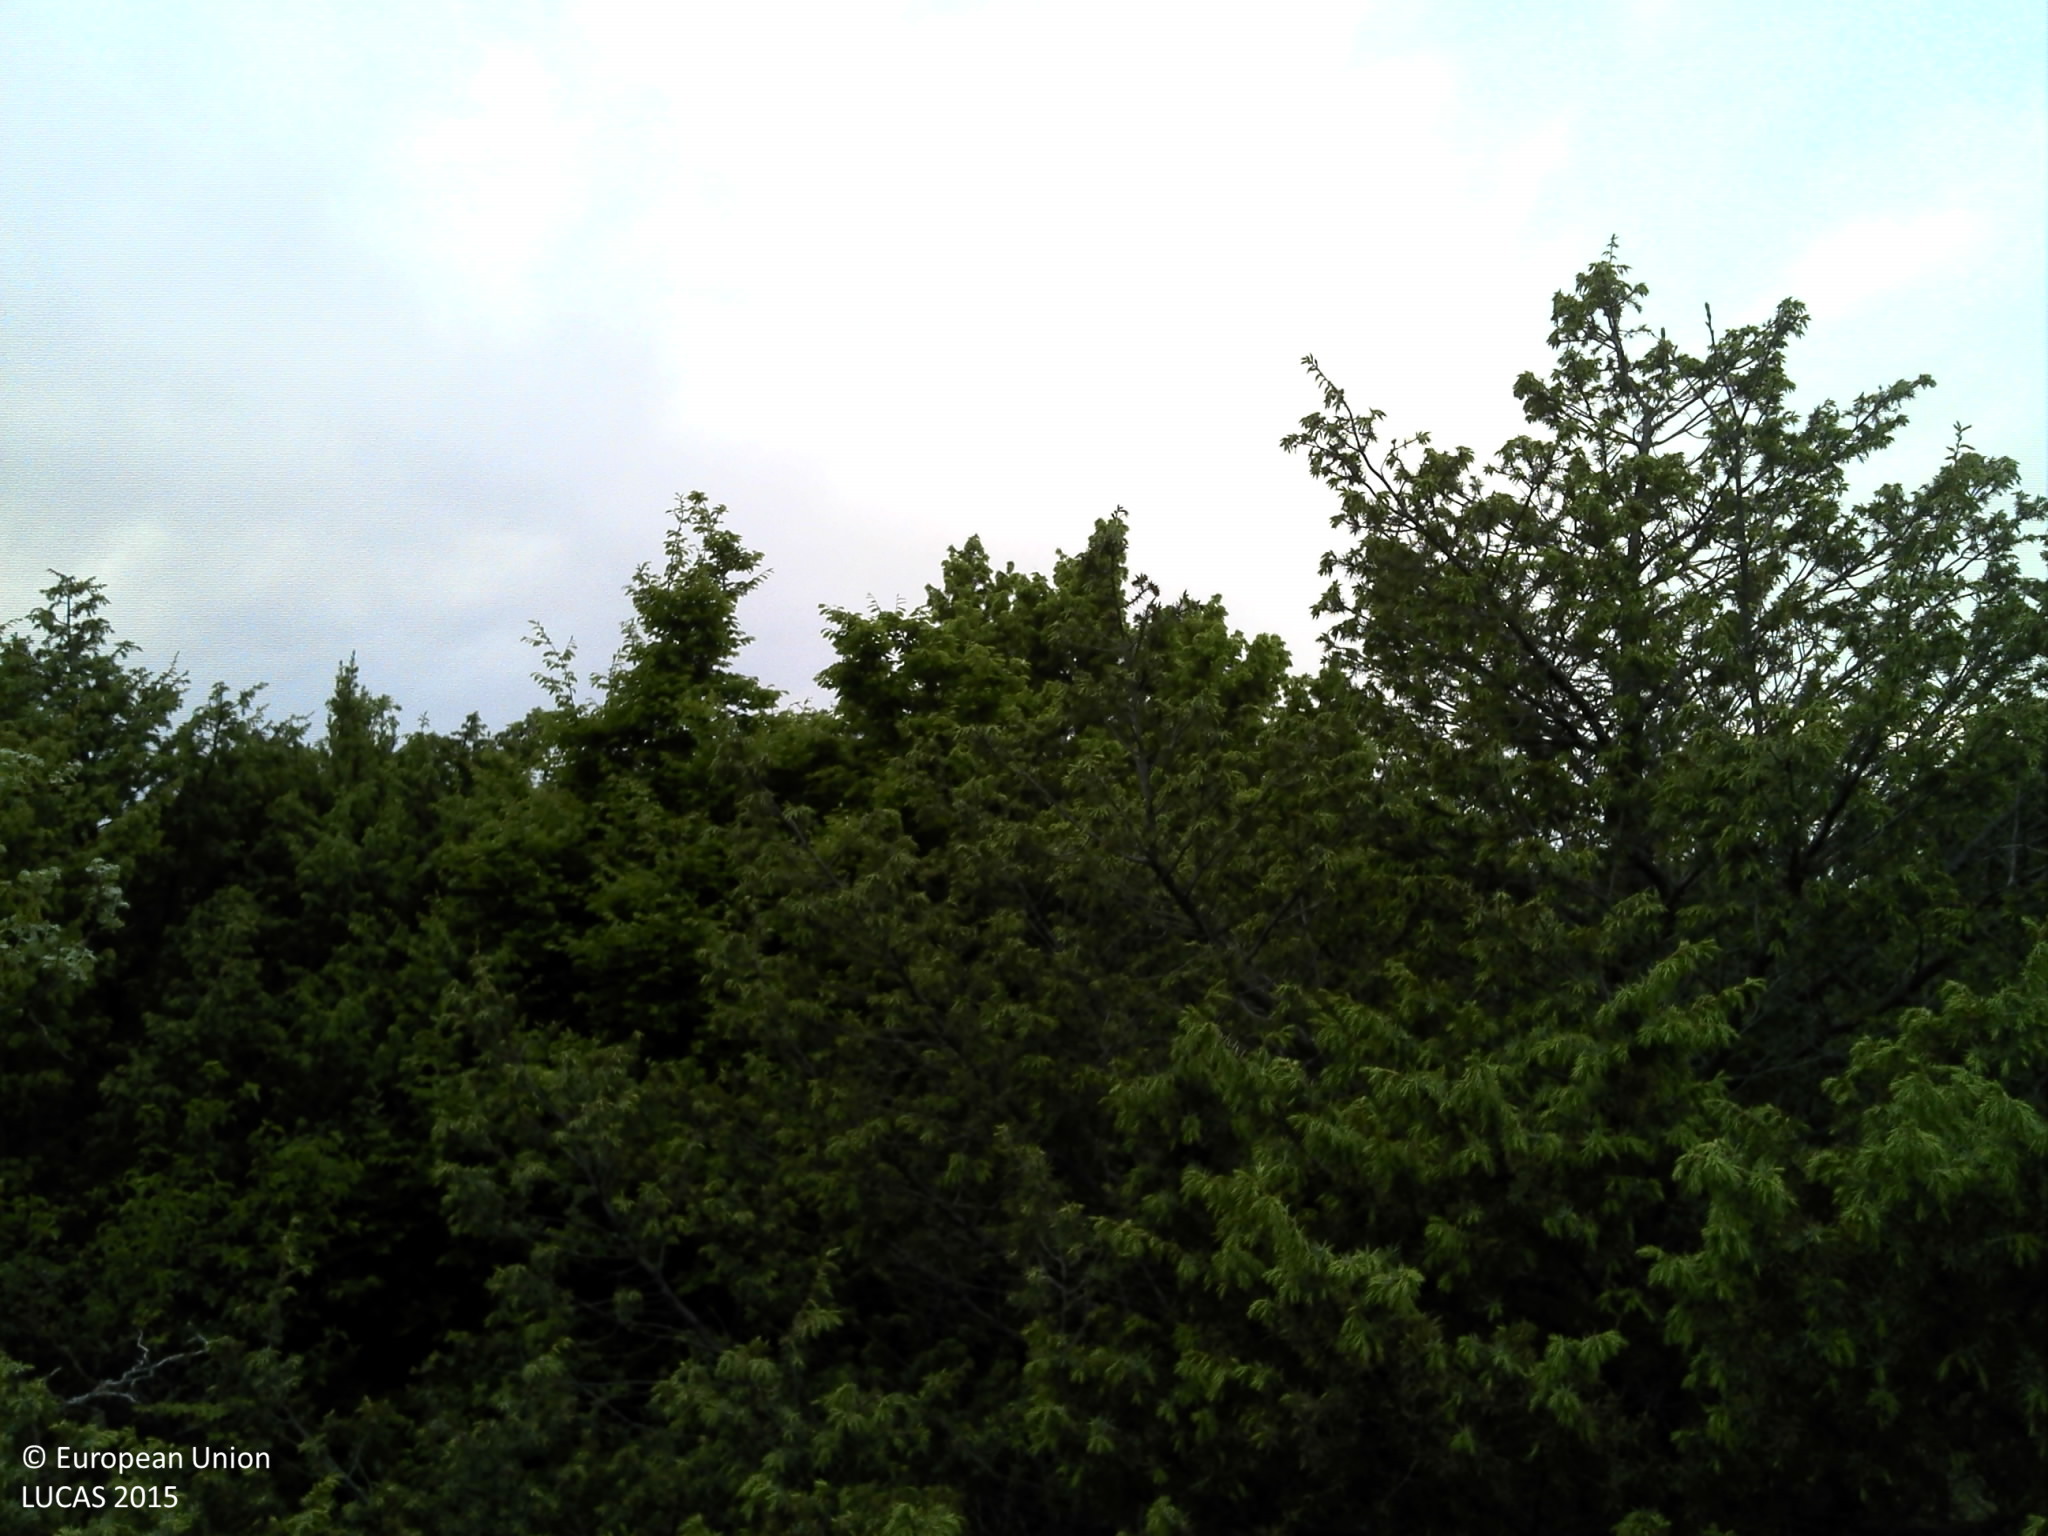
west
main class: Shrubland
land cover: Shrubland with sparse tree cover
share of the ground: 50 - 75 %
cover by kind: shrubs 45 %, herbaceous plants 30 %, unconsolidated bare surface 15 %, coniferous forest trees 5 %, consolidated bare surface 5 %
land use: Semi-natural and natural areas not in use
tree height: < 5 m
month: May
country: HR
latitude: 43.7960
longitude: 16.0192
